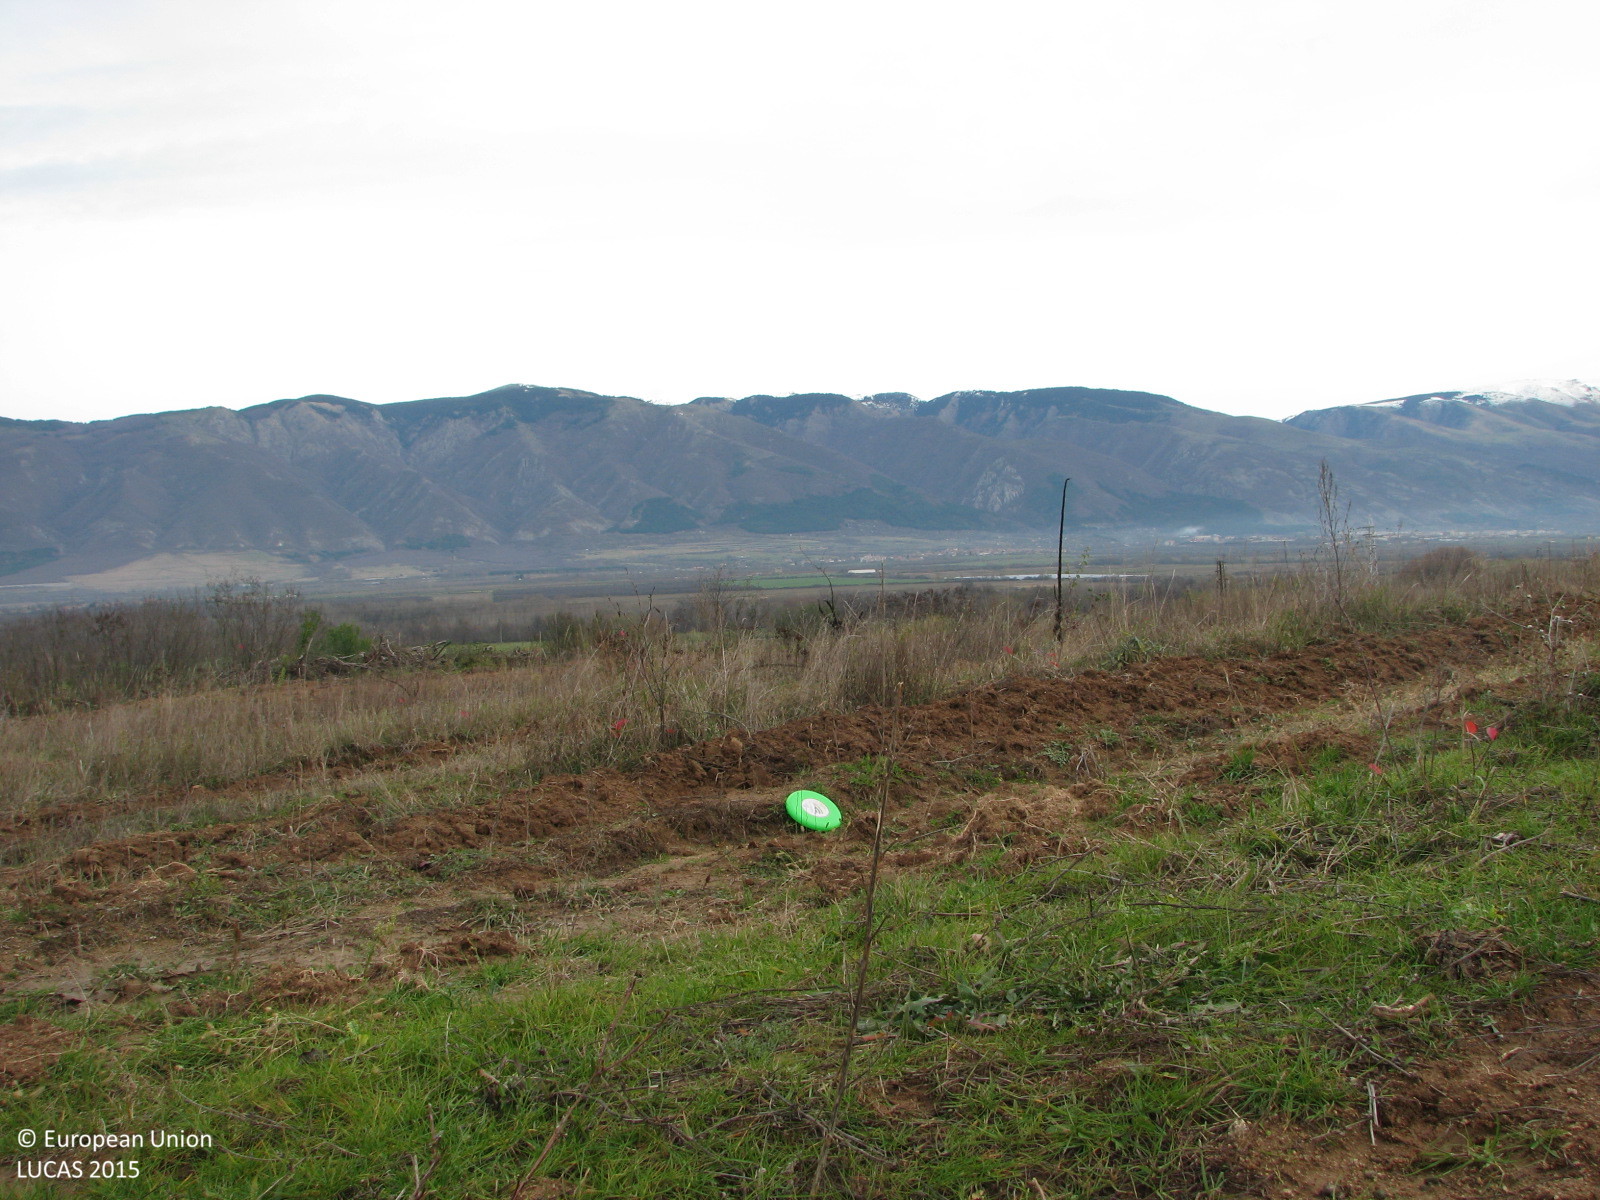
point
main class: Cropland
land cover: Other fruit trees and berries
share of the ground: 25 - 50 %
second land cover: Spontaneously vegetated surfaces
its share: 25 - 50 %
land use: Agriculture (excluding fallow land and kitchen gardens)
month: December
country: BG
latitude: 42.6230
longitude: 24.6743
